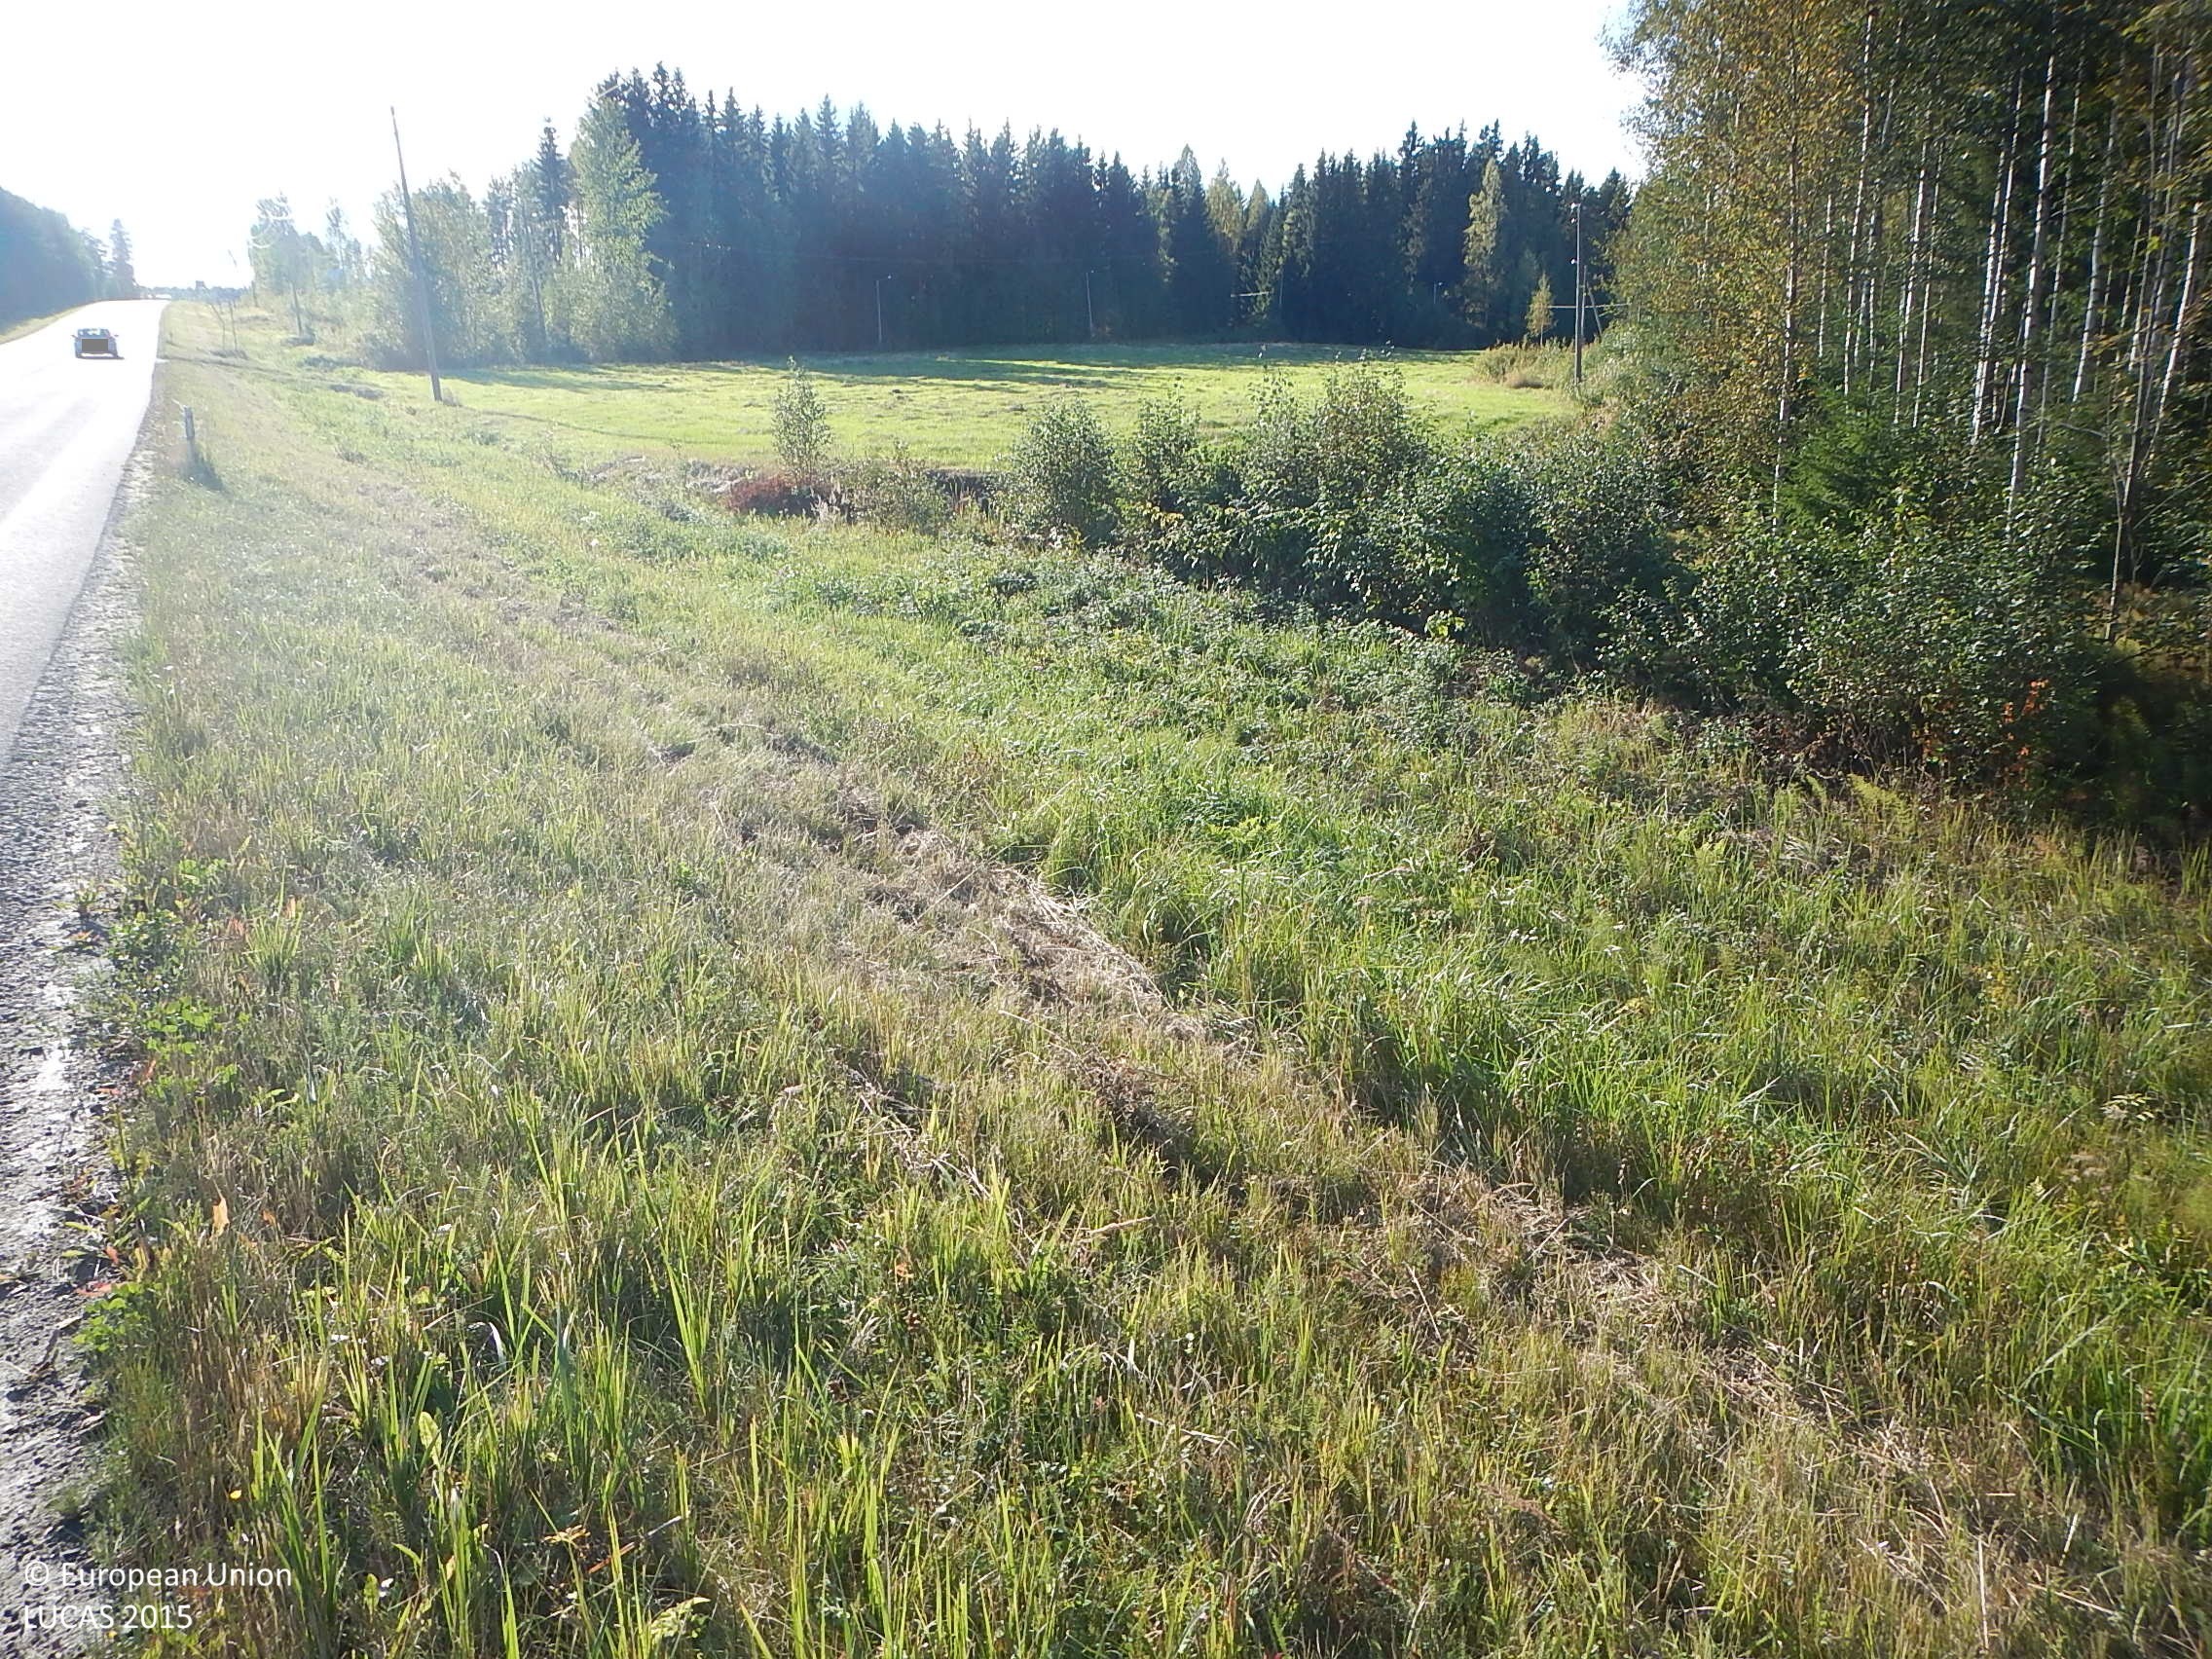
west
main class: Grassland
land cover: Grassland without tree/shrub cover
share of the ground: > 75 %
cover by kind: herbaceous plants 100 %
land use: Road transport
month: September
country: FI
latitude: 61.4780
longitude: 22.5868
